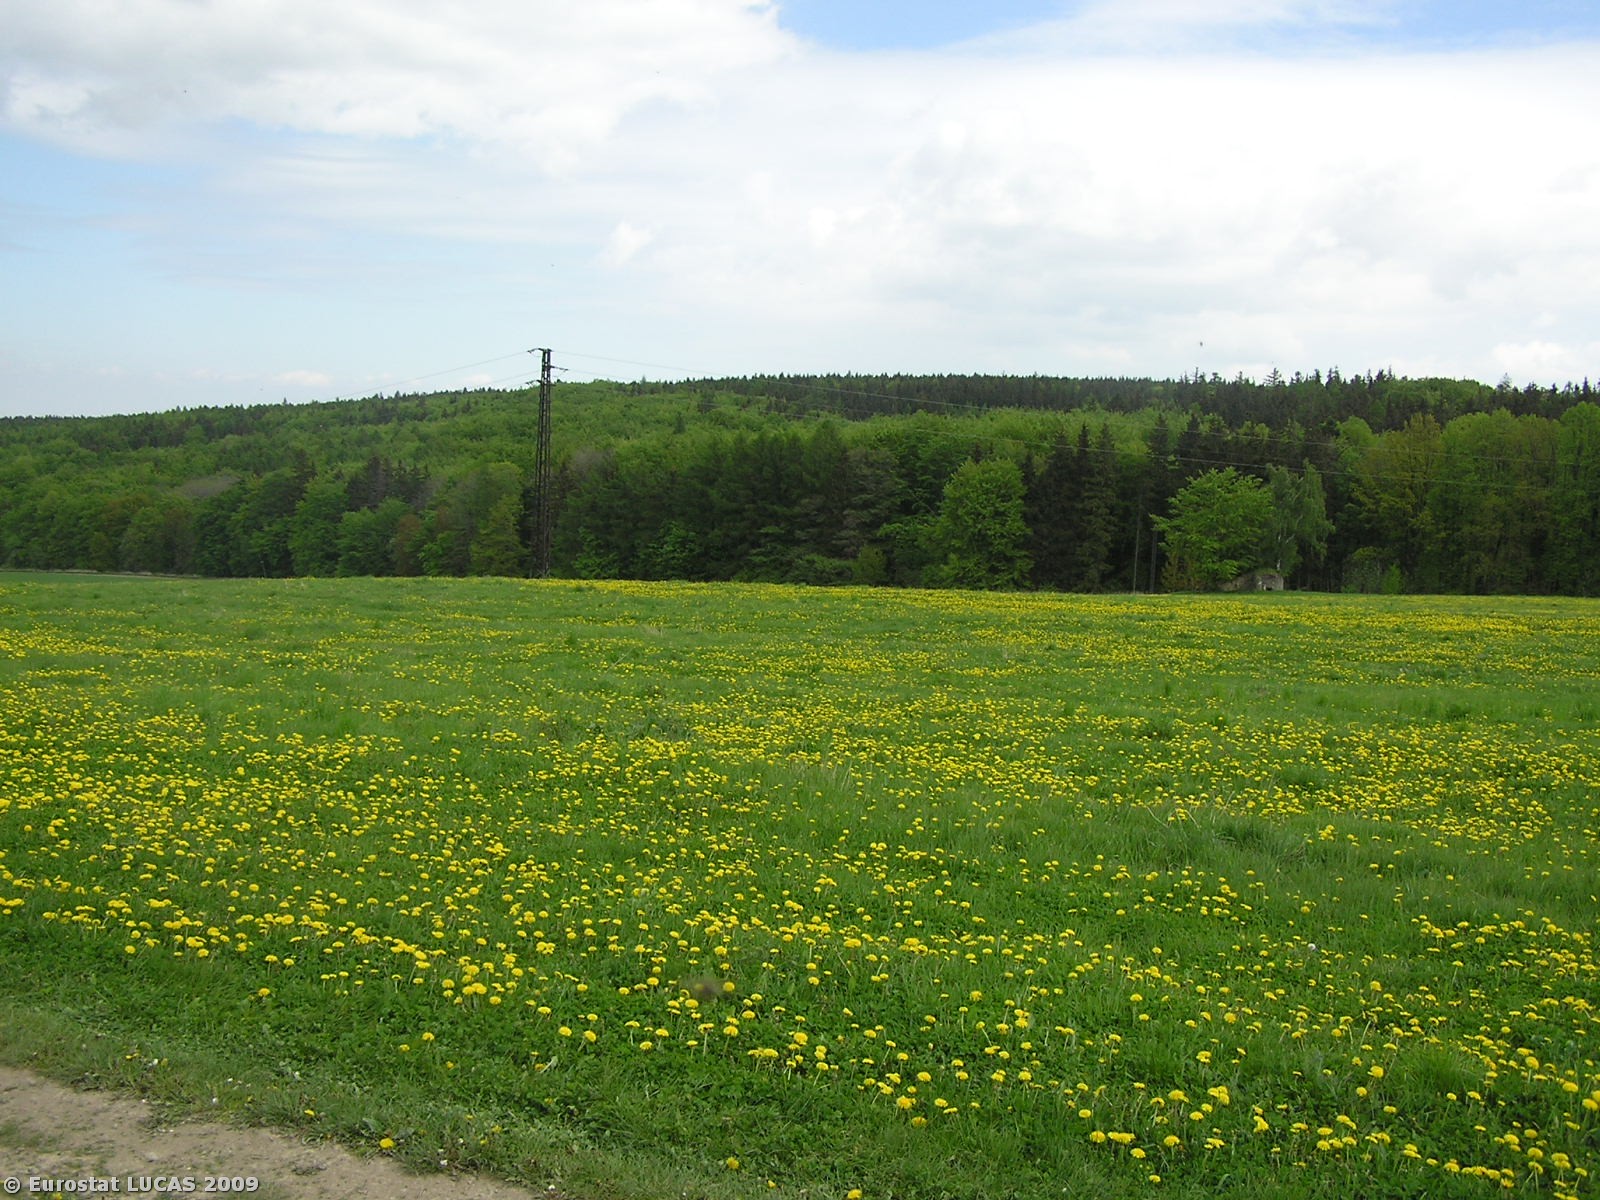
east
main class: Grassland
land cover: Grassland without tree/shrub cover
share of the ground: > 75 %
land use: Agriculture (excluding fallow land and kitchen gardens)
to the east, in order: Grassland without tree/shrub cover; Tracks; Grassland without tree/shrub cover; Electric lines; Grassland without tree/shrub cover; Barley; Bare land; Grassland with sparse tree/shrub cover
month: May
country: CZ
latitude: 49.9837
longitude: 17.6138
